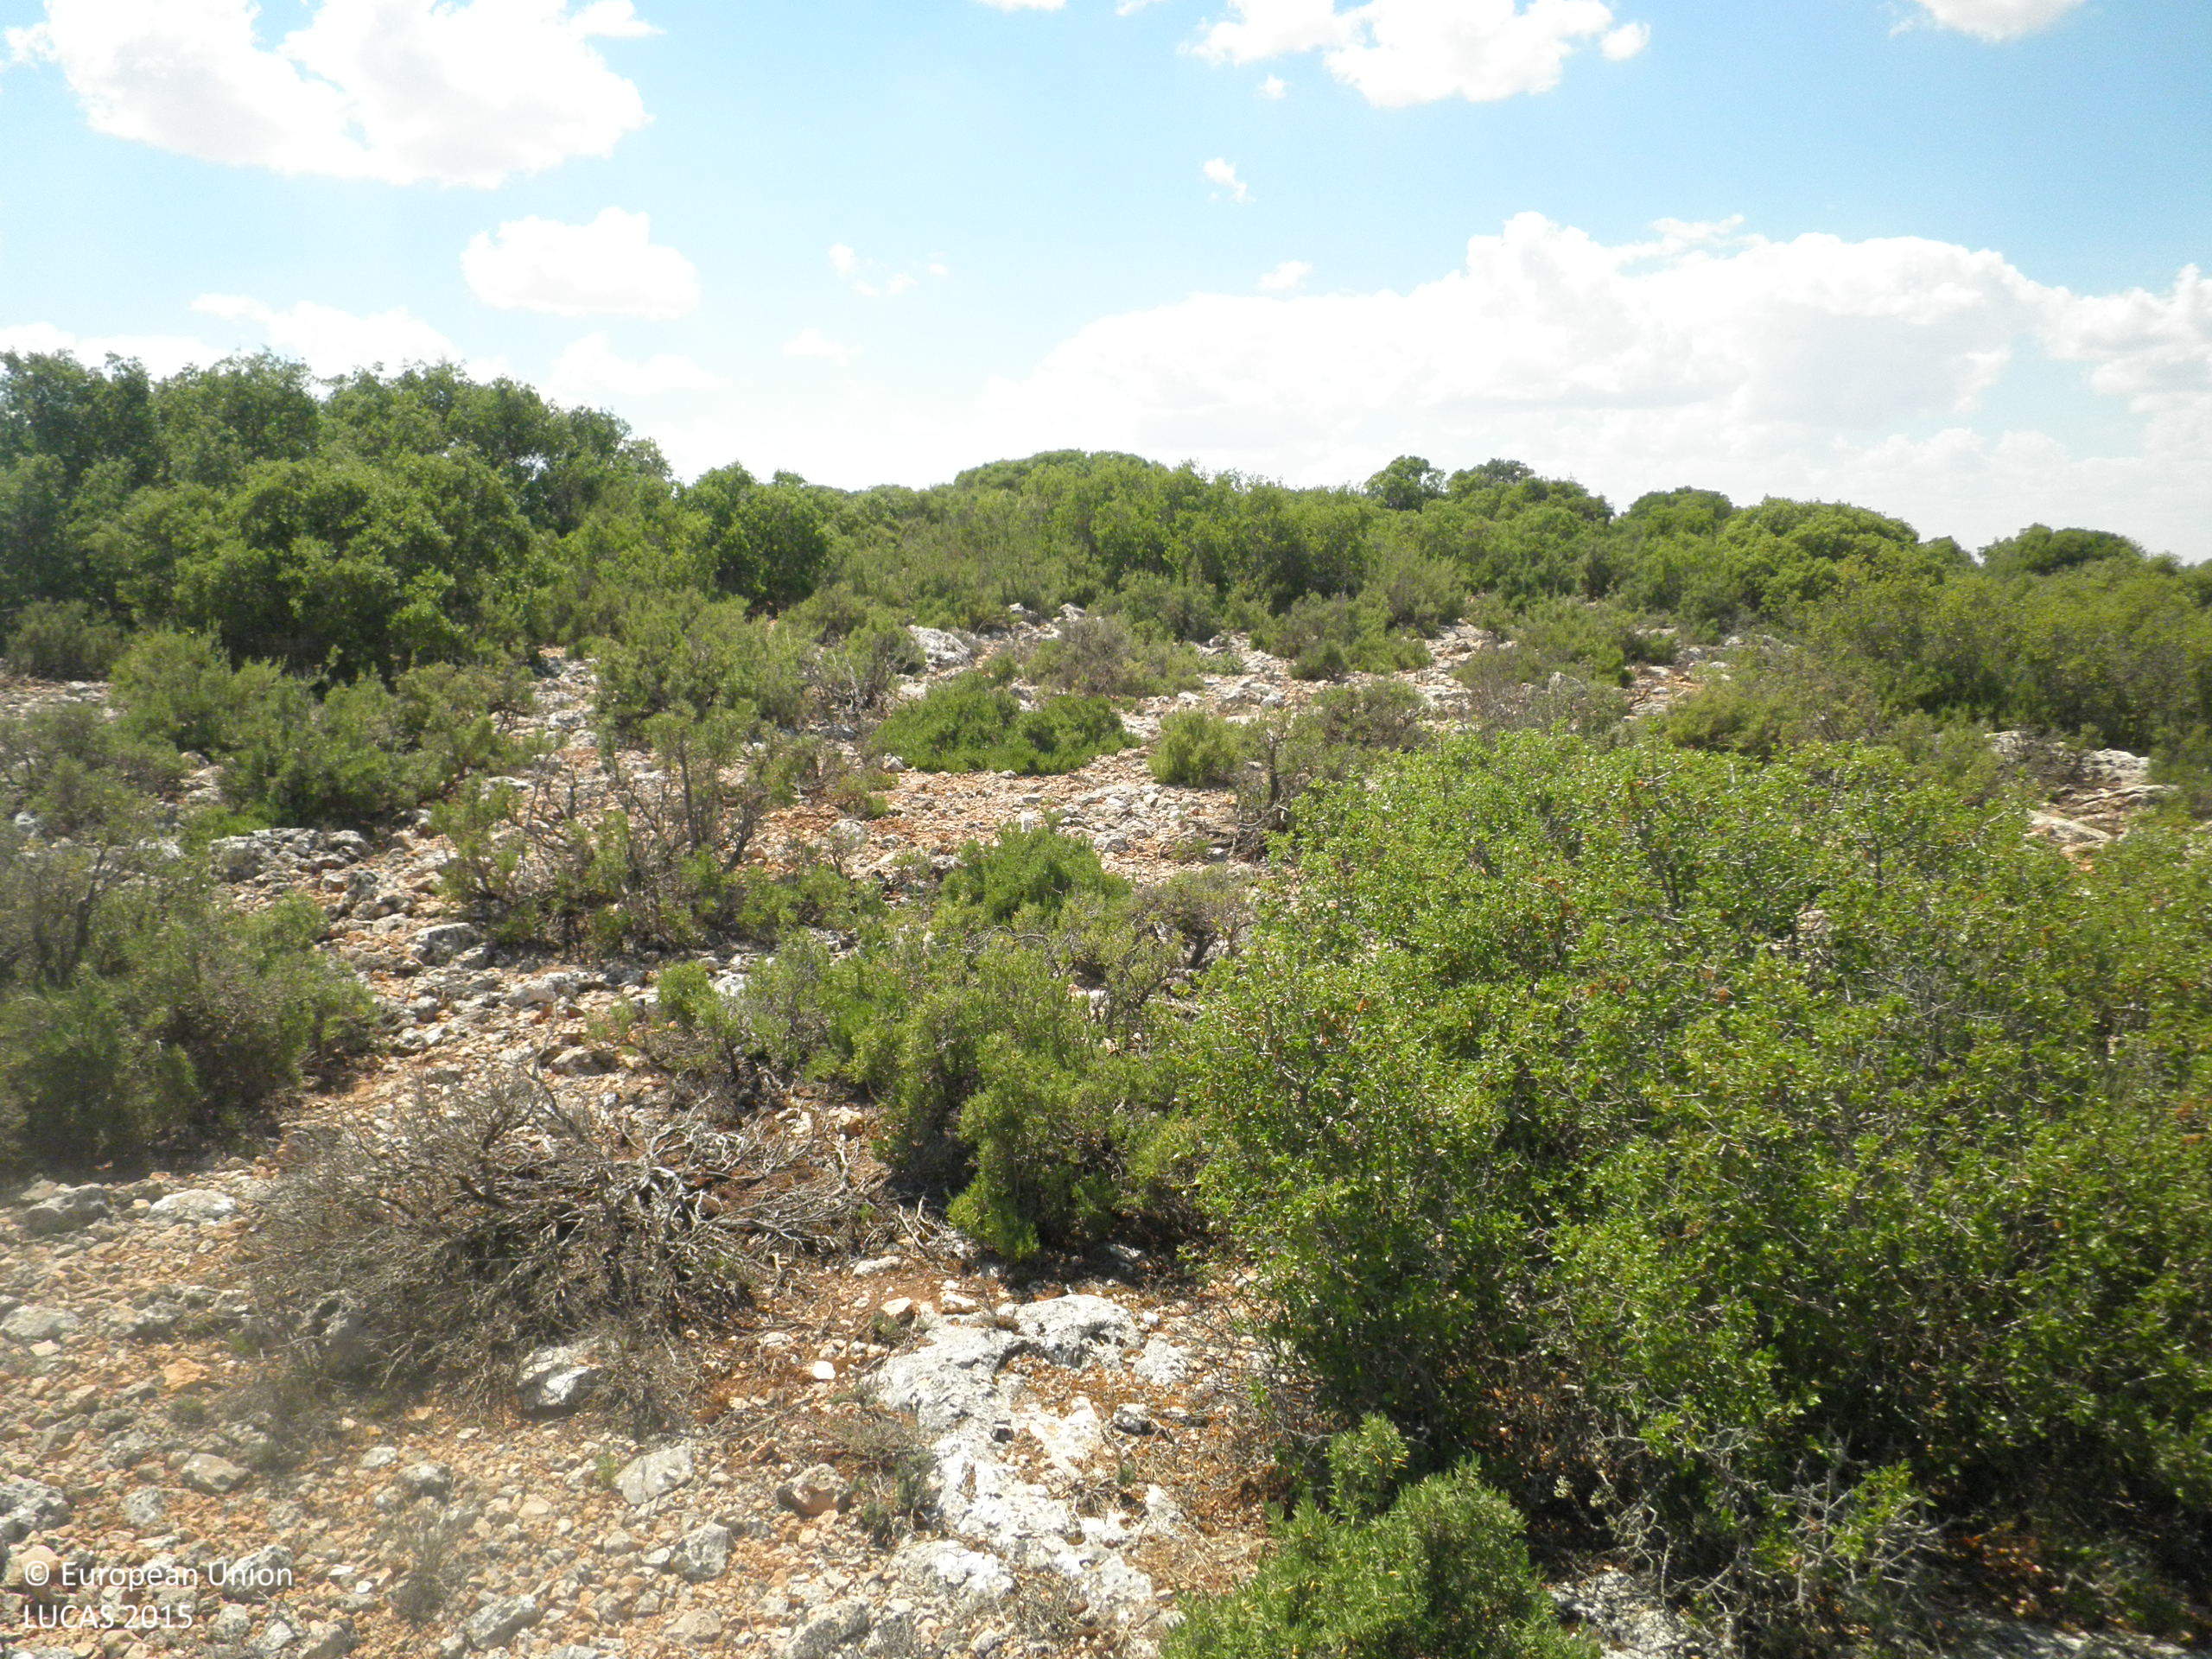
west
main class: Shrubland
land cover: Shrubland without tree cover
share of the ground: 25 - 50 %
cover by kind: consolidated bare surface 50 %, shrubs 40 %, unconsolidated bare surface 10 %
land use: Semi-natural and natural areas not in use
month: June
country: ES
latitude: 39.4844
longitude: -1.7599
